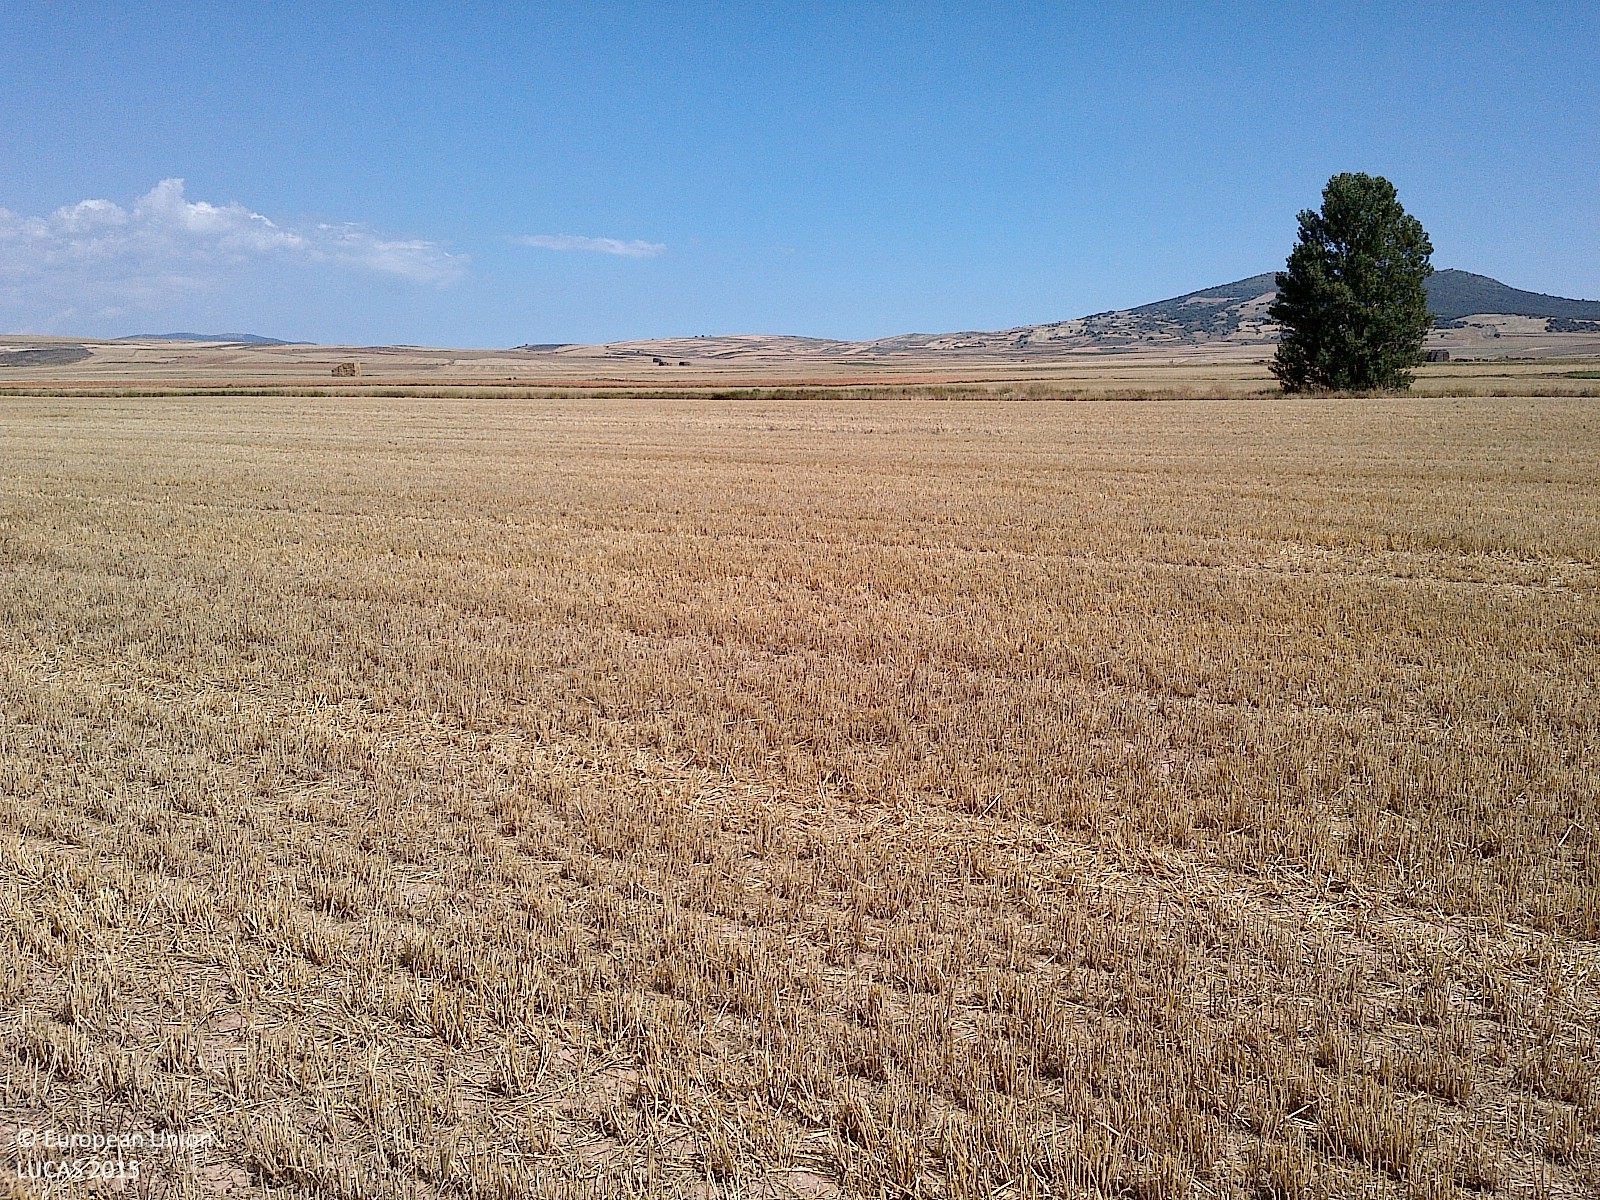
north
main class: Cropland
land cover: Barley
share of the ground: < 10 %
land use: Agriculture (excluding fallow land and kitchen gardens)
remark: Harvested field
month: July
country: ES
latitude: 41.8624
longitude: -2.0207
